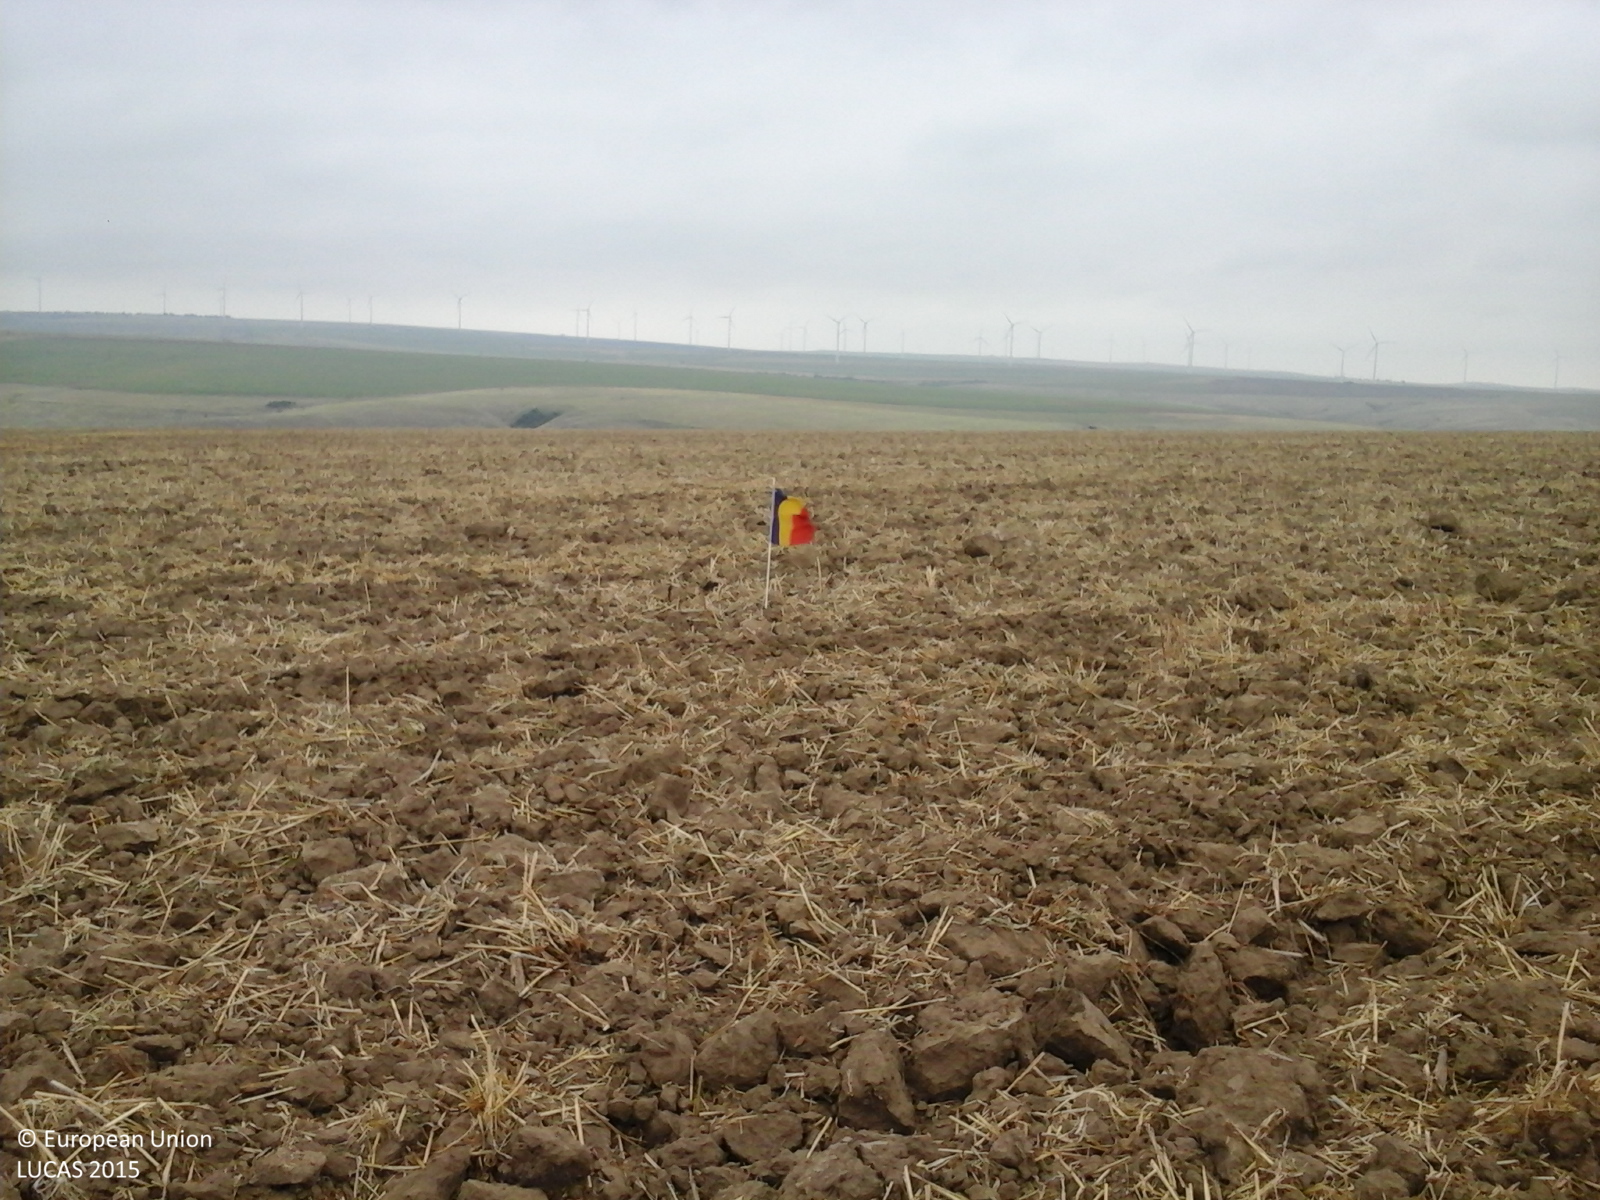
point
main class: Cropland
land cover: Common wheat
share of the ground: < 10 %
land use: Agriculture (excluding fallow land and kitchen gardens)
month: August
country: RO
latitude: 44.8249
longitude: 28.3208
